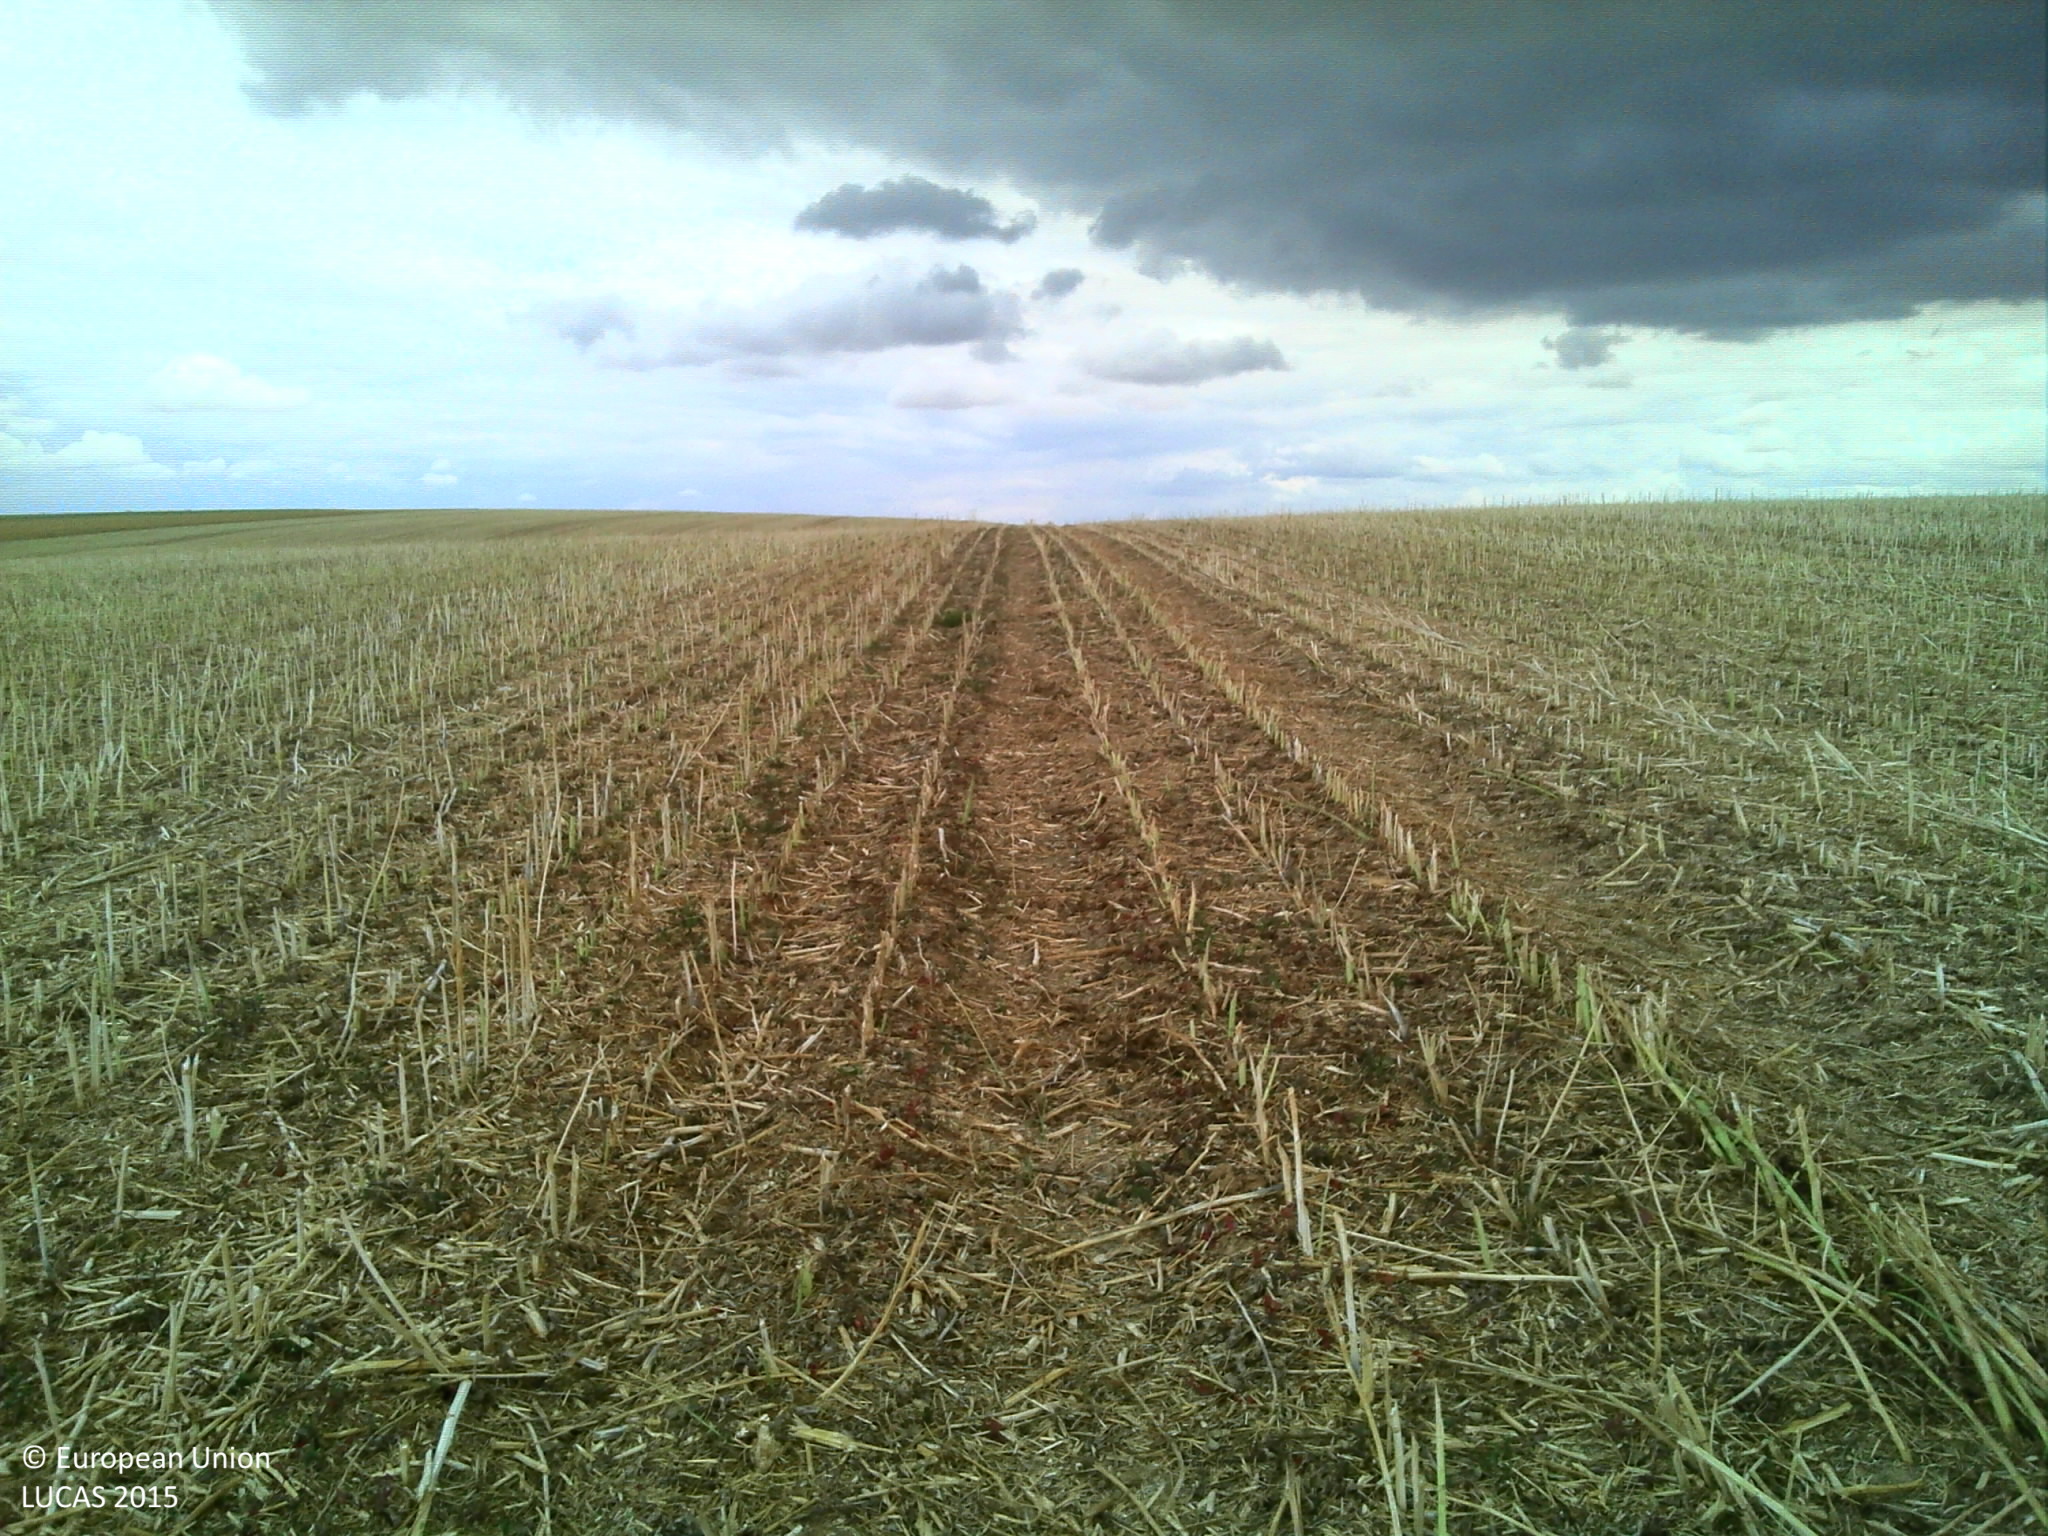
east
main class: Cropland
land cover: Rape and turnip rape
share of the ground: > 75 %
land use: Agriculture (excluding fallow land and kitchen gardens)
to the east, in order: Rape and turnip rape
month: July
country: FR
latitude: 49.0990
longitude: 4.5594
